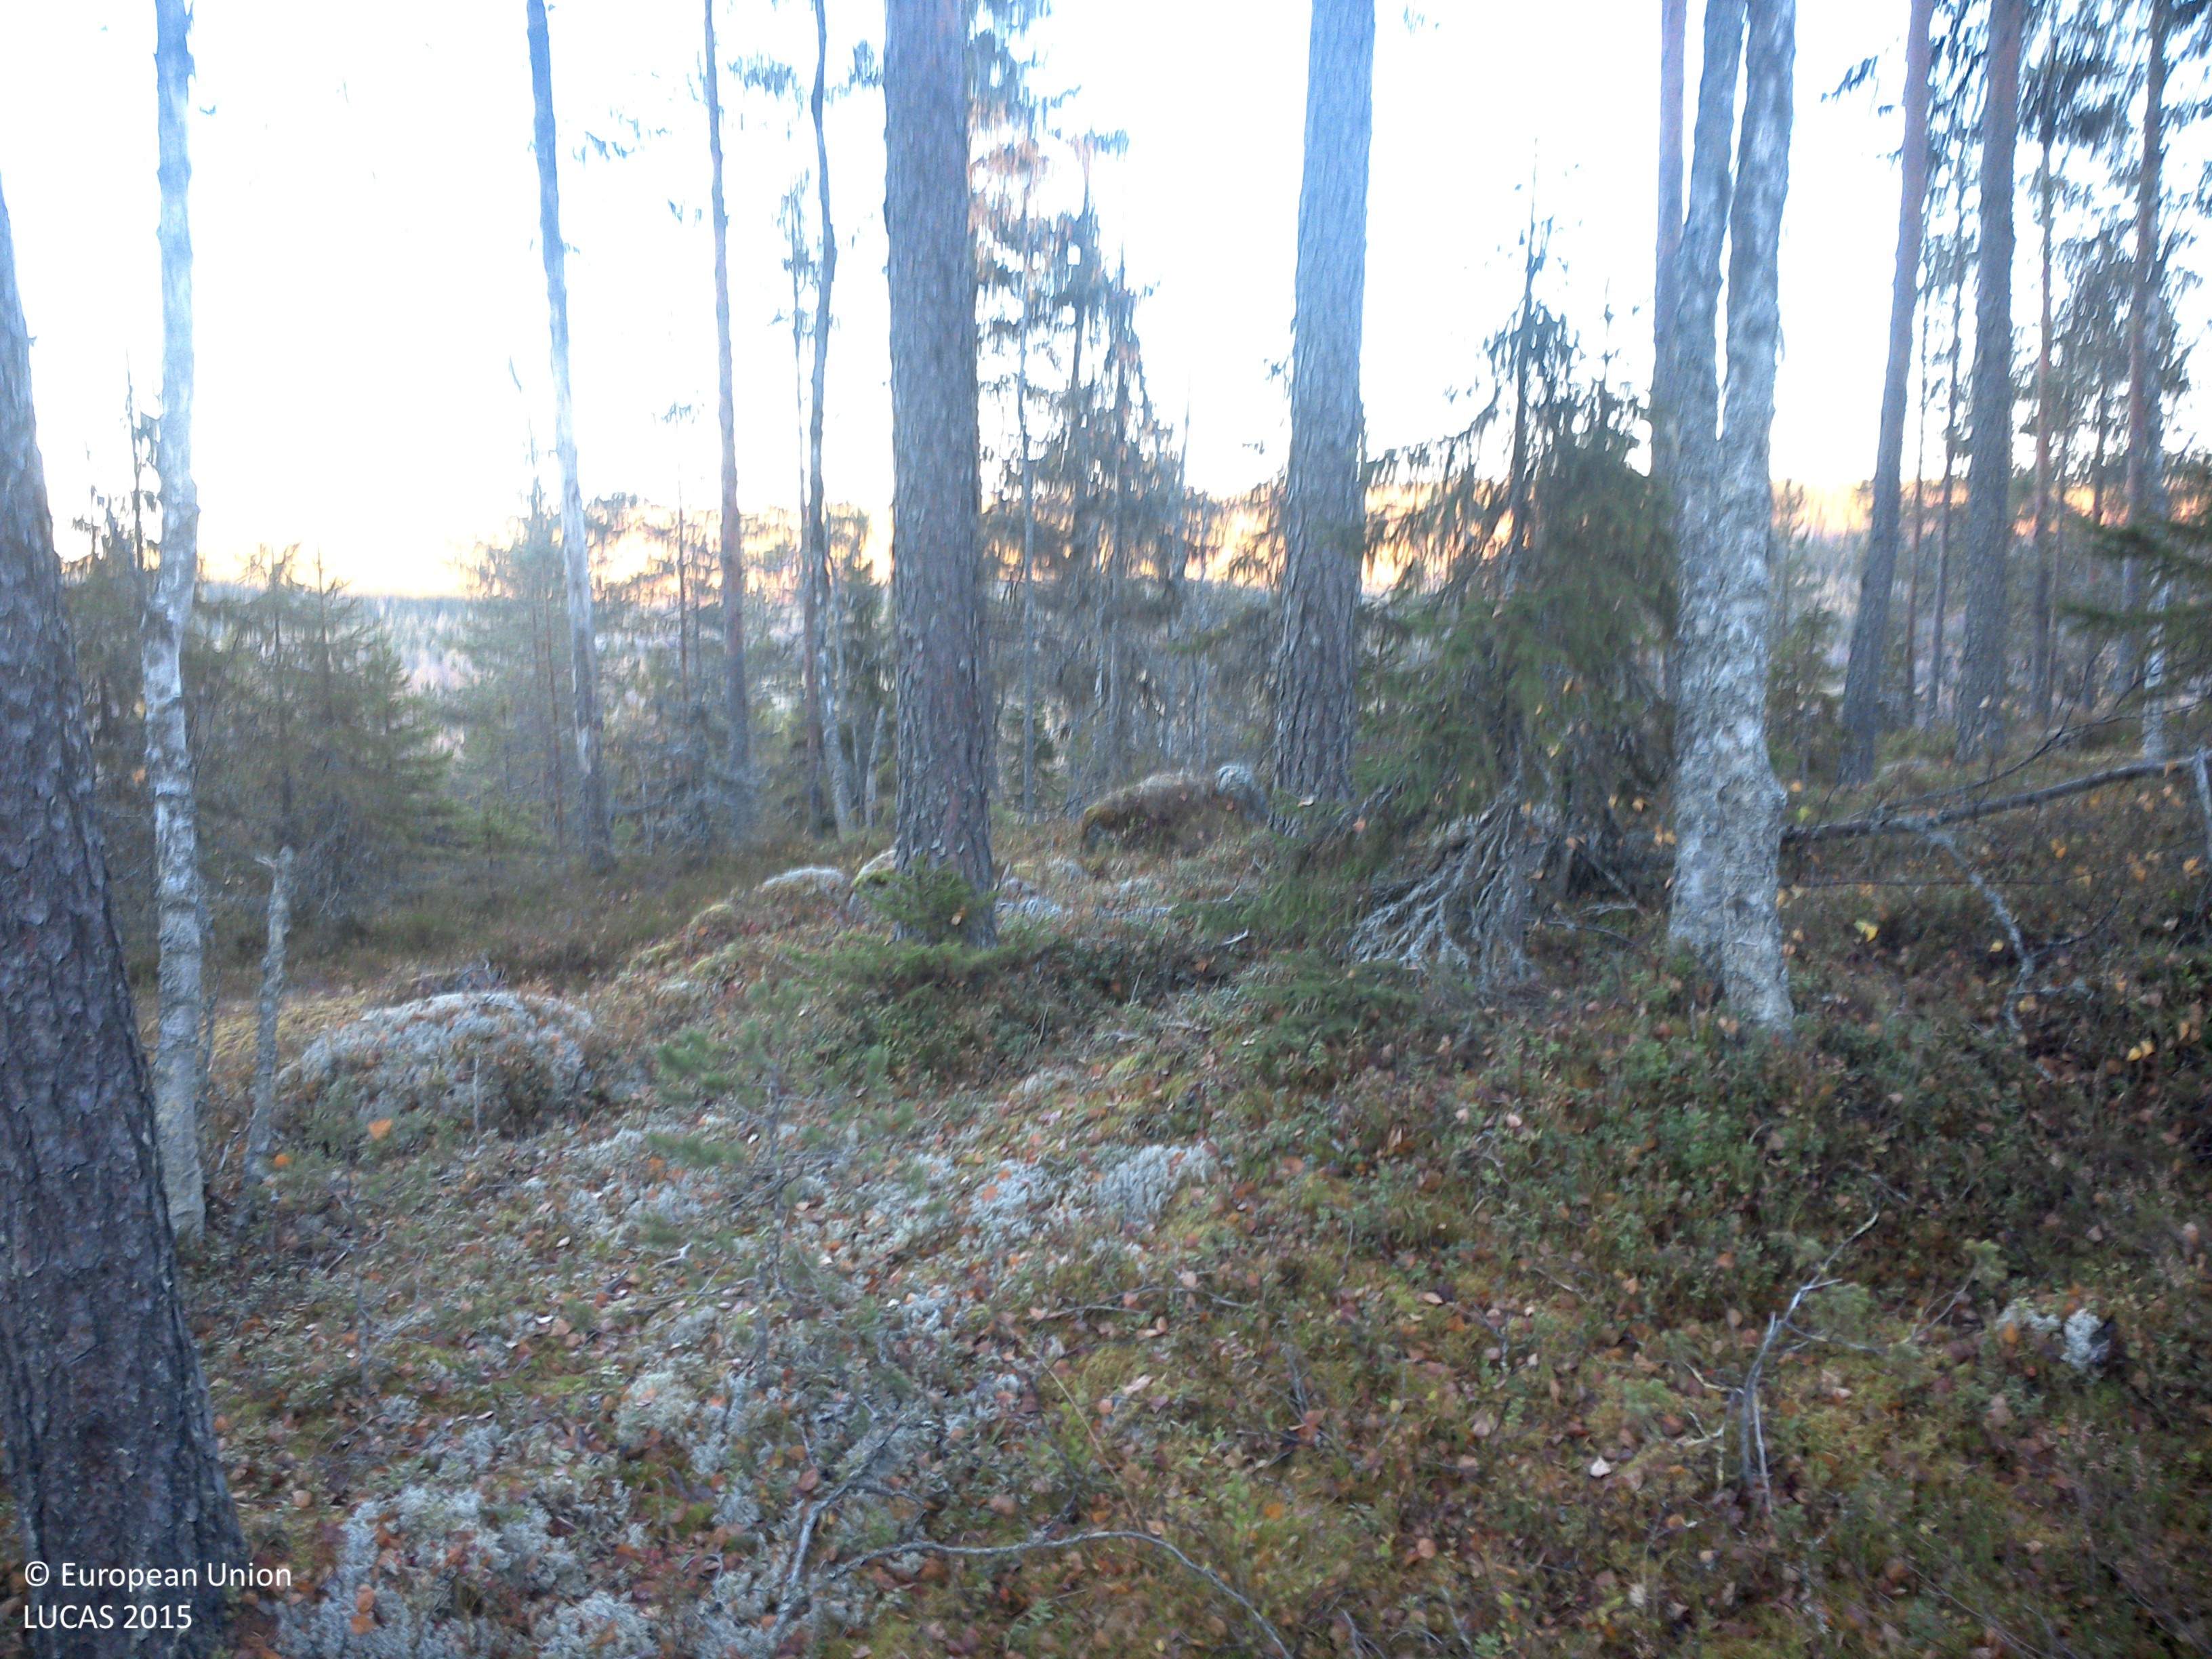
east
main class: Woodland
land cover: Pine dominated mixed woodland
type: boreal forest
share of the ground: 25 - 50 %
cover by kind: shrubs 50 %, coniferous forest trees 30 %, broadleaved forest trees 20 %
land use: Forestry
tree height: > 5 m
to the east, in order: Pine dominated mixed woodland; Spruce dominated mixed woodland; Broadleaved woodland; Tracks; Grassland without tree/shrub cover
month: October
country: SE
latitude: 63.8727
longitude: 19.8502
